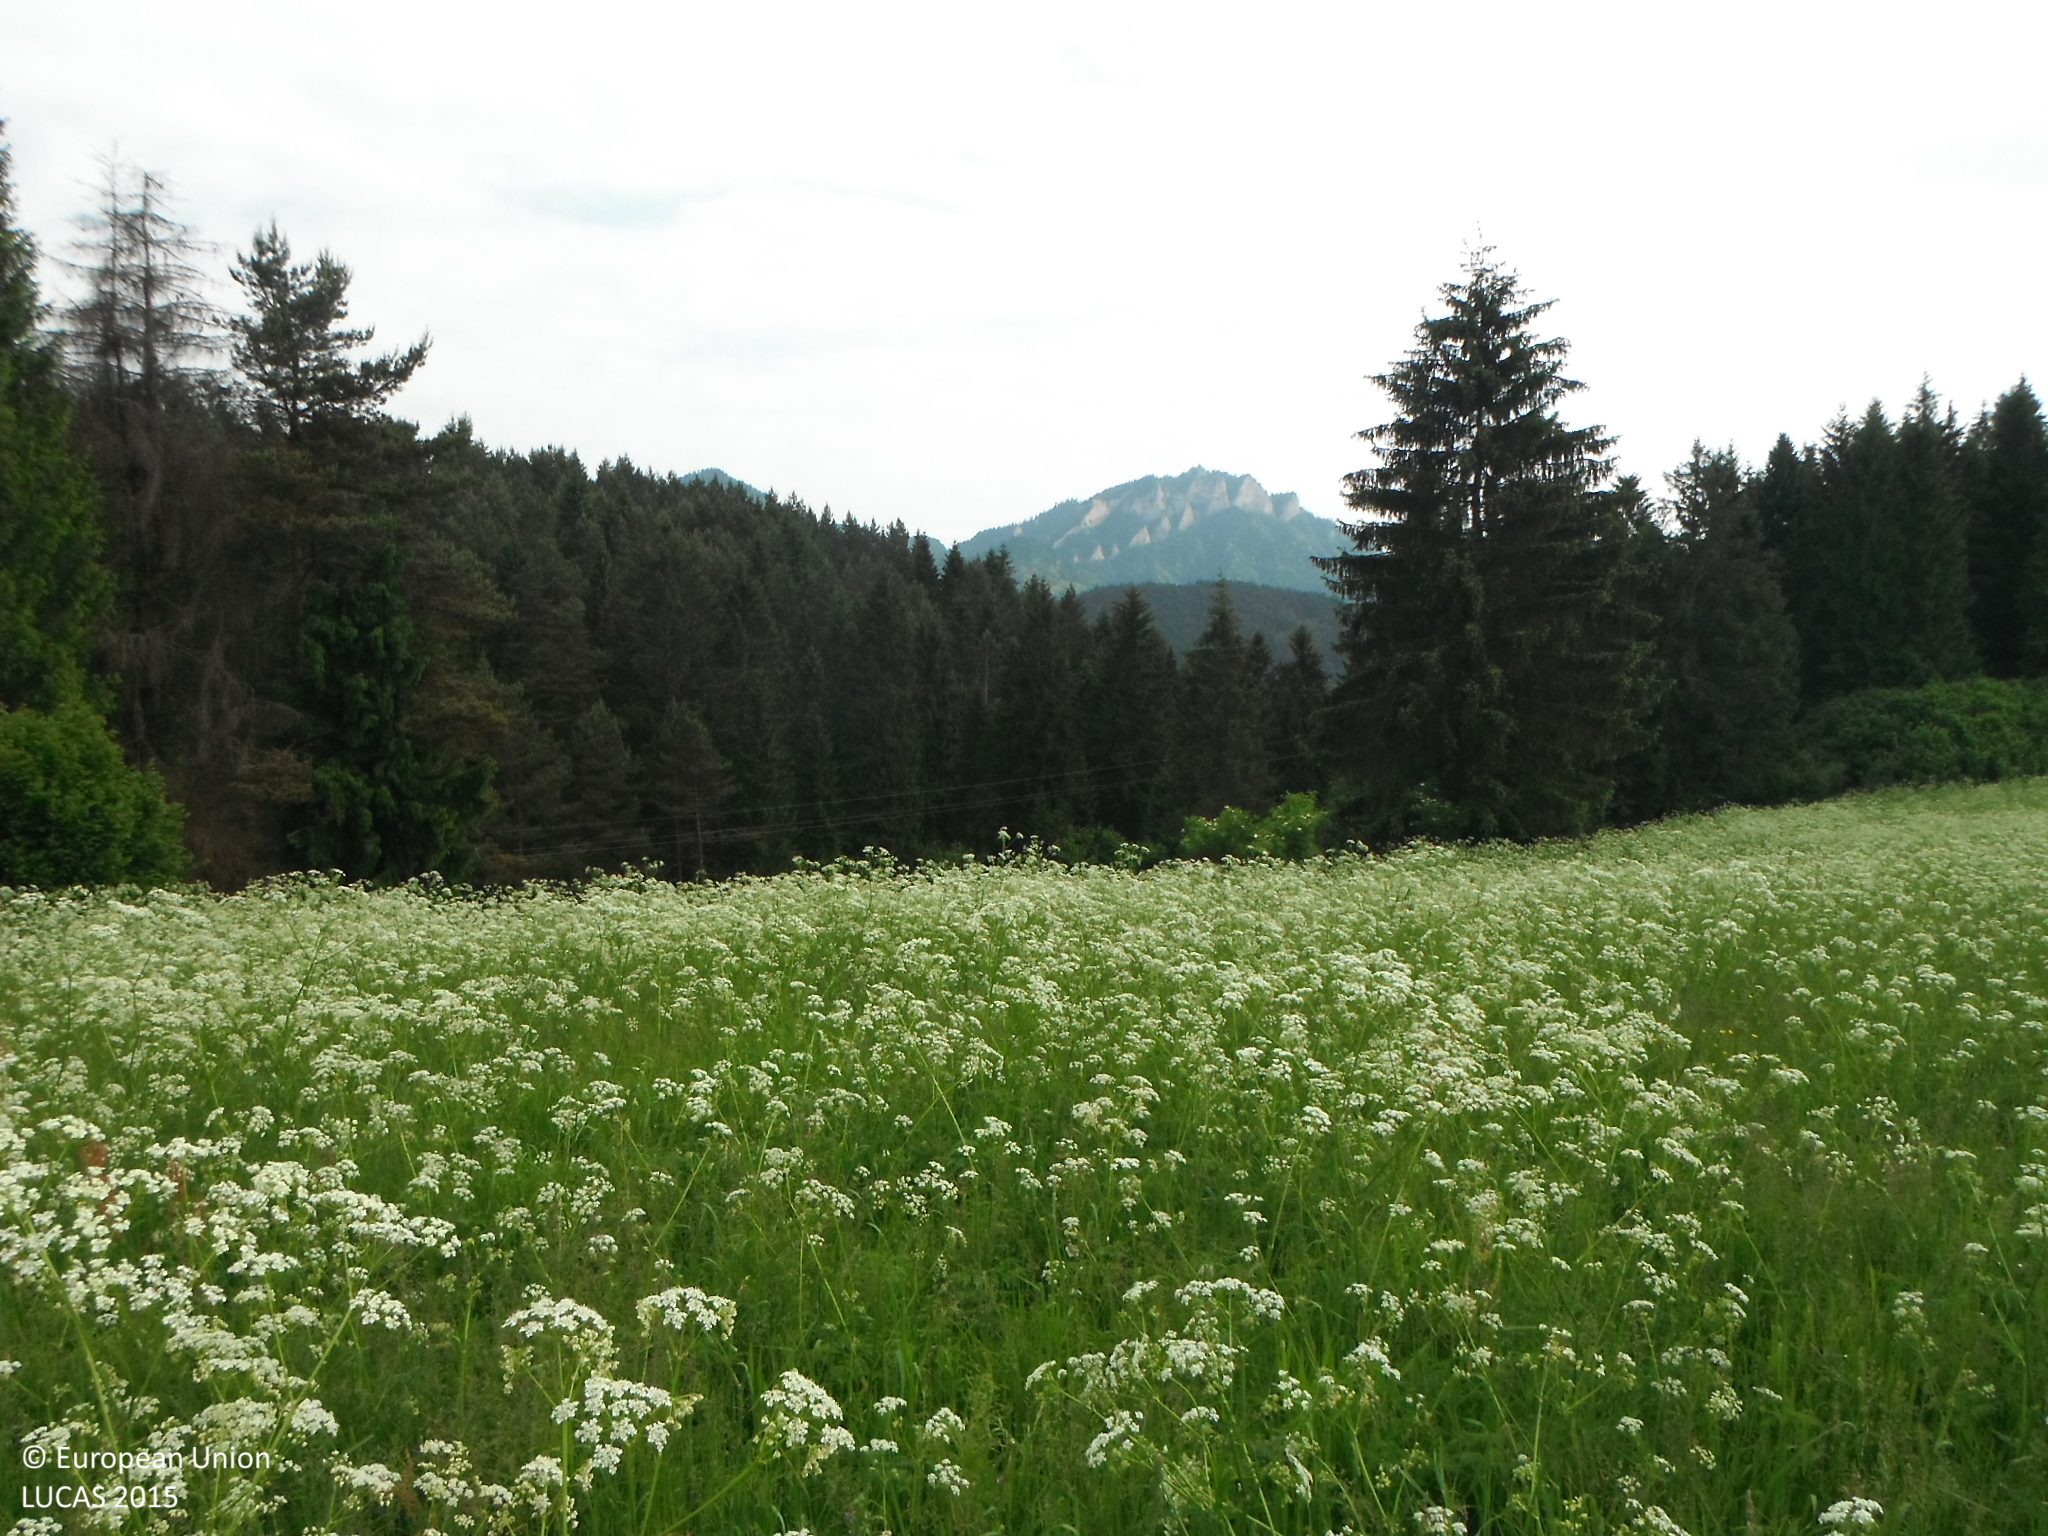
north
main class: Grassland
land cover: Grassland without tree/shrub cover
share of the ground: > 75 %
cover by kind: herbaceous plants 100 %
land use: Agriculture (excluding fallow land and kitchen gardens)
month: June
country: SK
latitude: 49.3827
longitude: 20.3804
